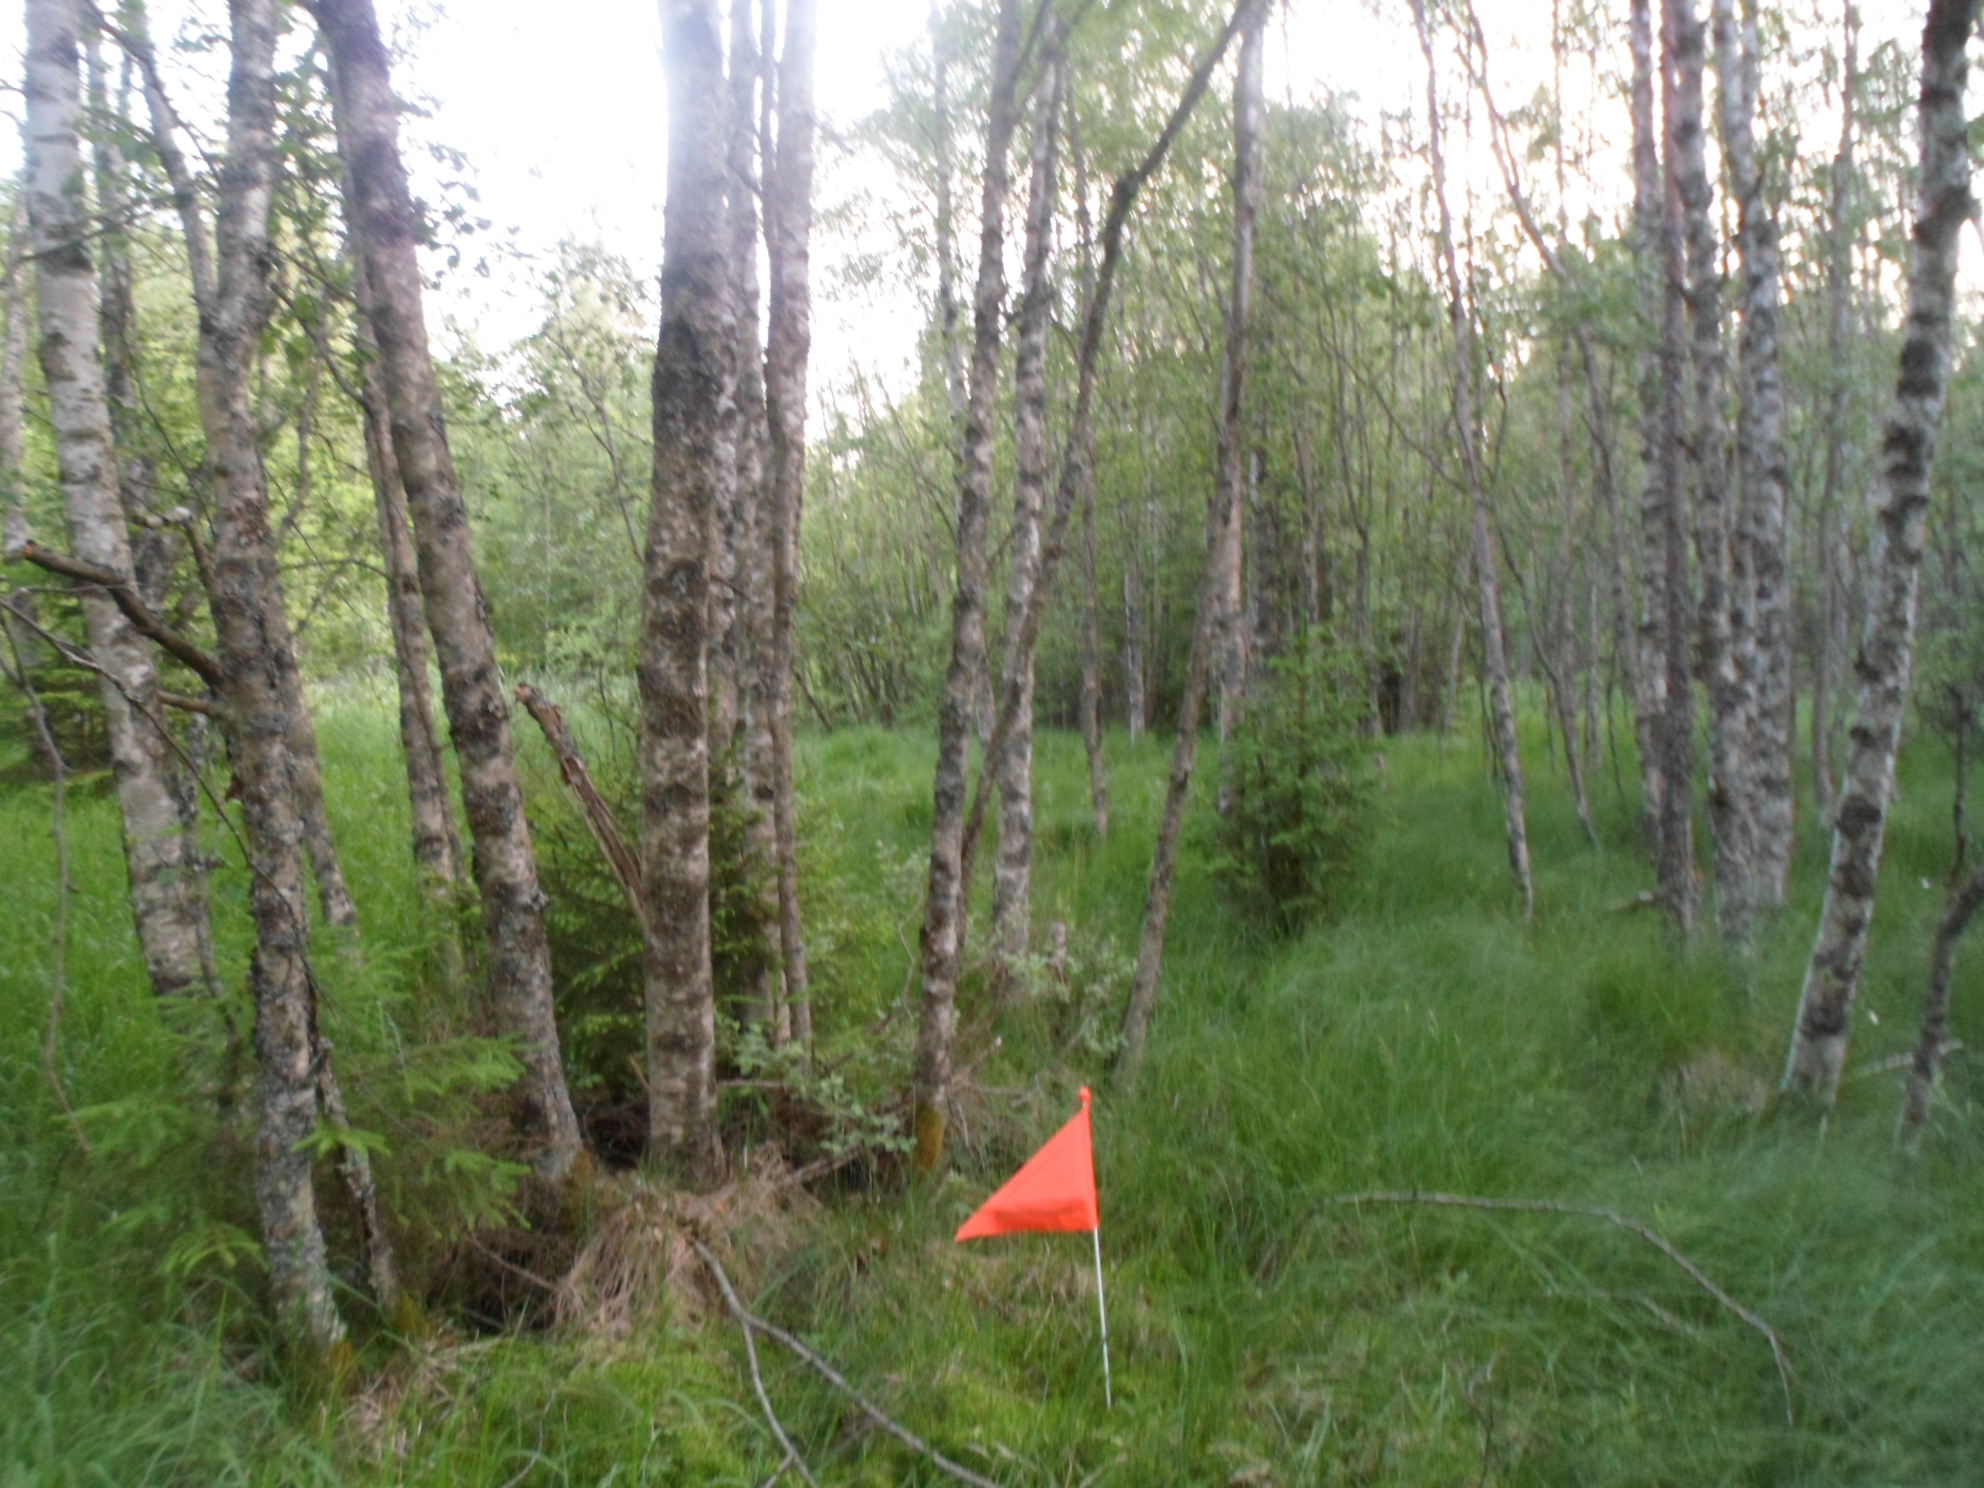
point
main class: Woodland
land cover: Broadleaved woodland
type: mire and swamp forests
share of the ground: 50 - 75 %
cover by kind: broadleaved forest trees 60 %, herbaceous plants 25 %, lichens and mosses 10 %, shrubs 5 %
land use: Forestry
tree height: > 5 m
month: June
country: SE
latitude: 57.1044
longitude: 15.3298
